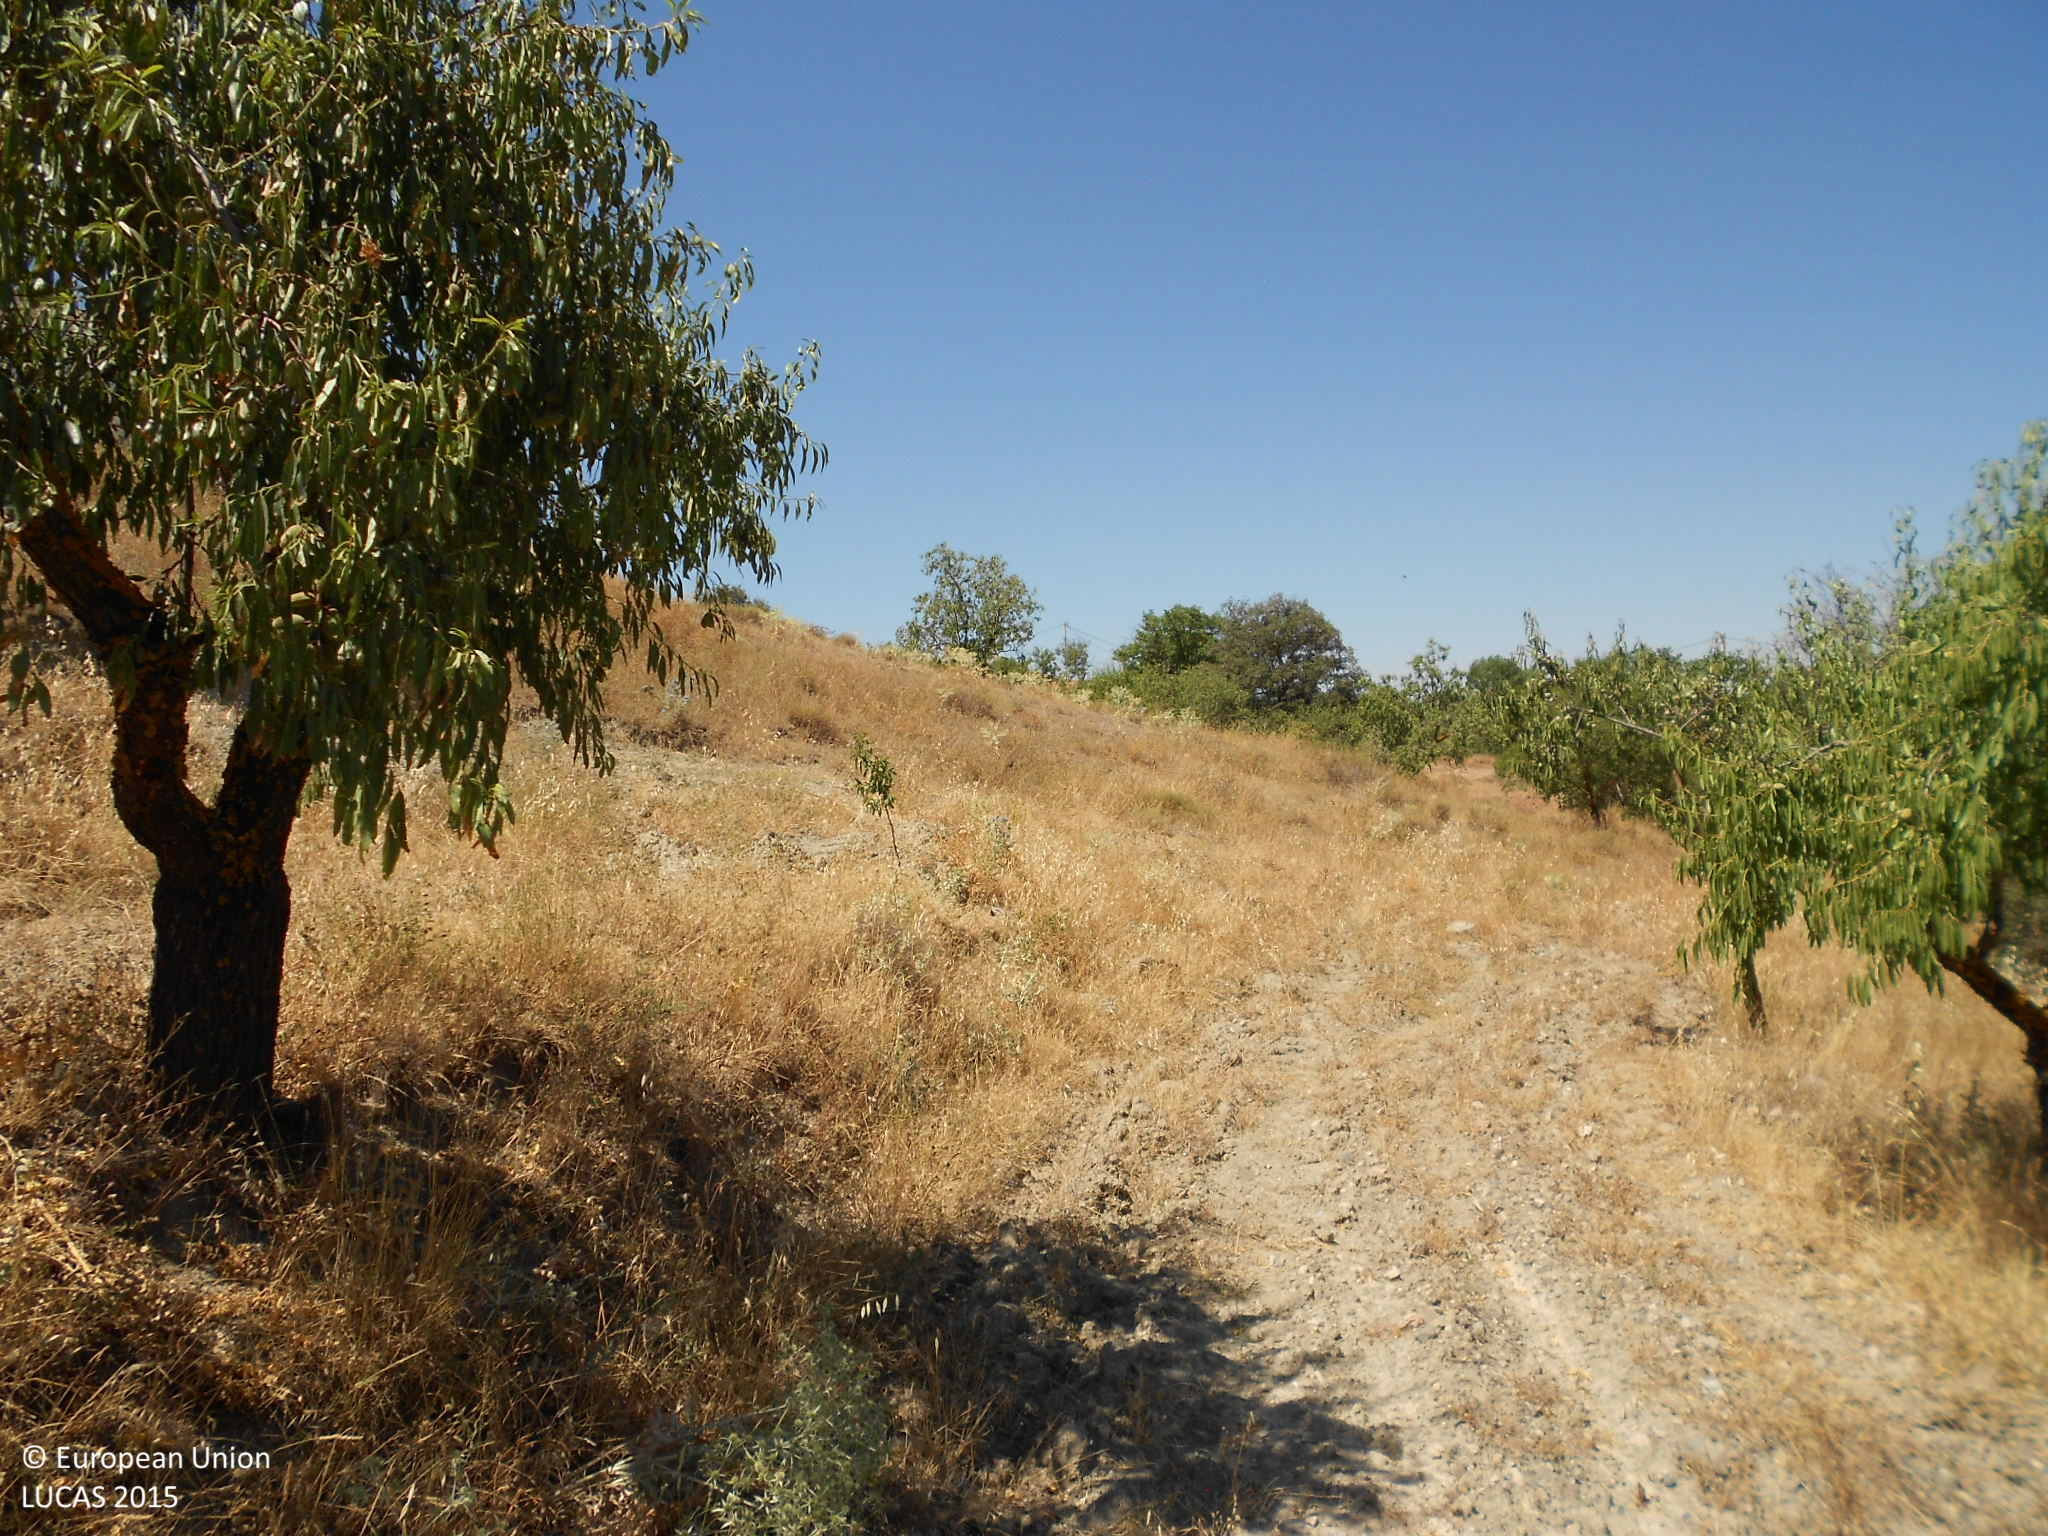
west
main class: Cropland
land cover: Nuts trees
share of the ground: 25 - 50 %
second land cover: Spontaneously vegetated surfaces
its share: 10 - 25 %
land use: Agriculture (excluding fallow land and kitchen gardens)
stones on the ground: > 50 %
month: July
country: ES
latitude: 37.5964
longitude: -2.2282
